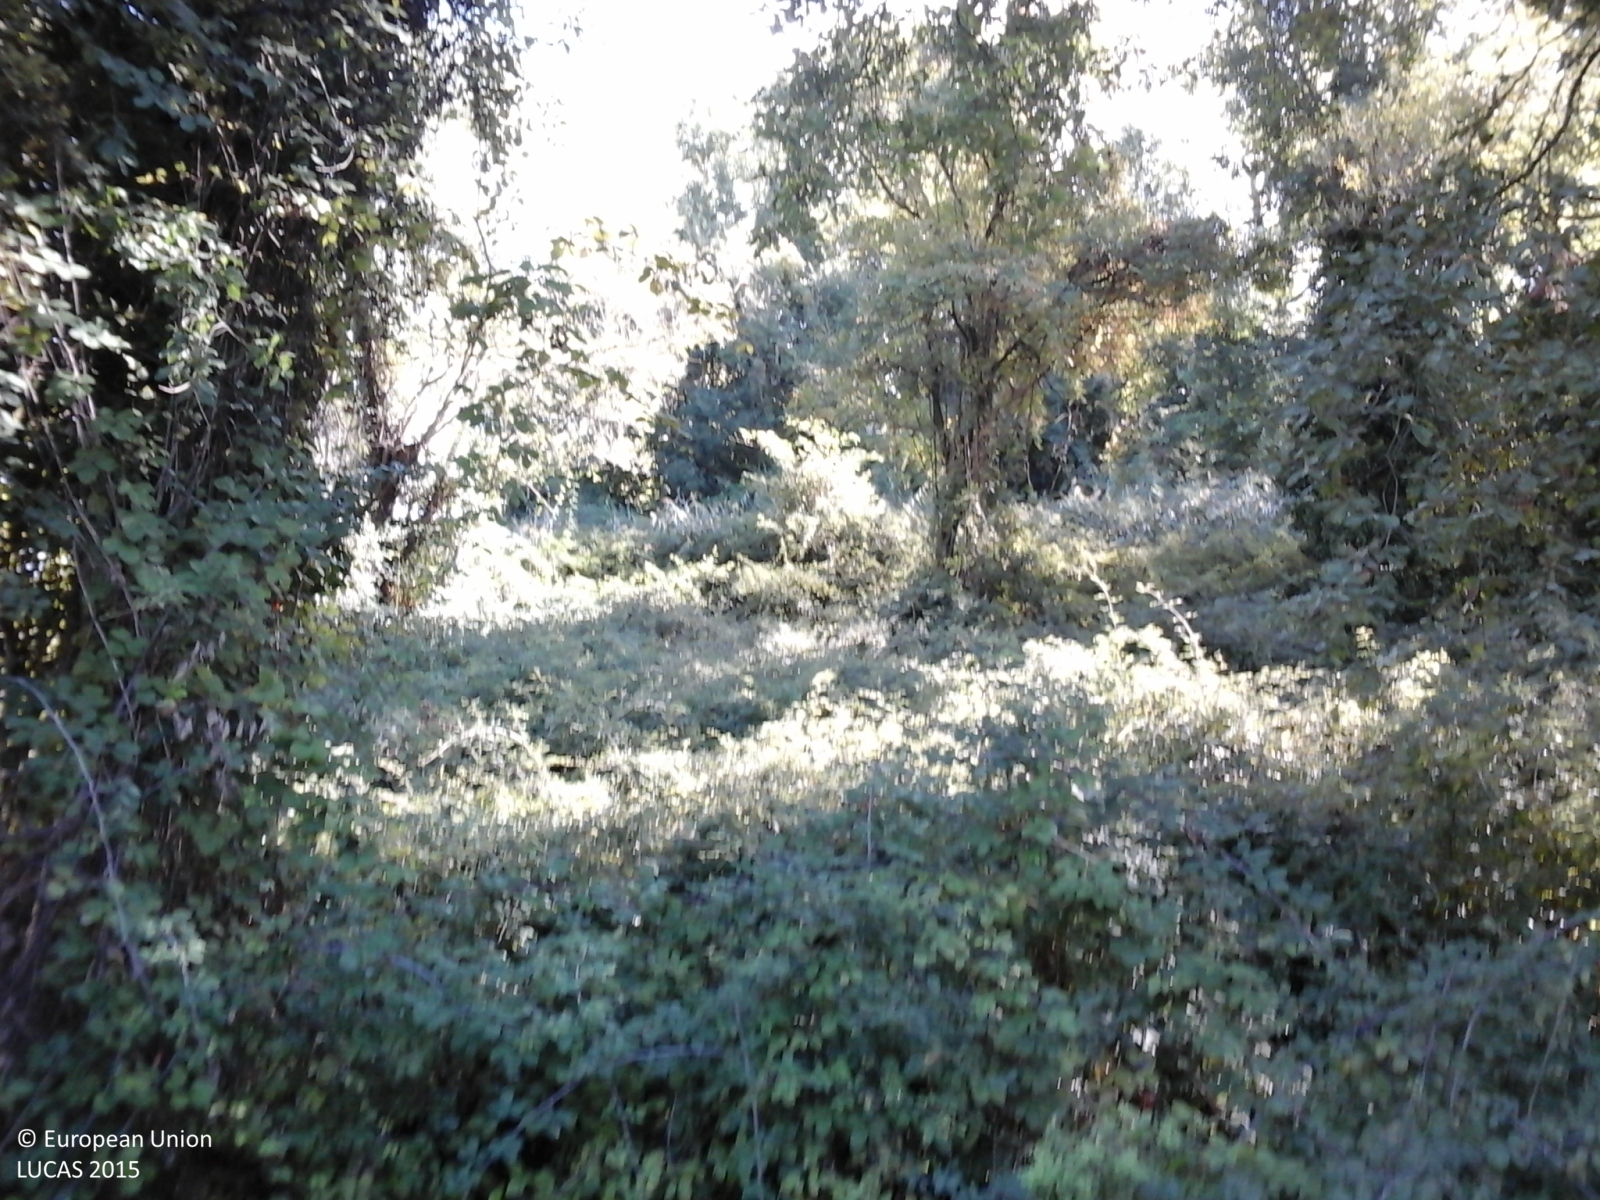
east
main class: Woodland
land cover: Broadleaved woodland
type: thermophilous deciduous forest
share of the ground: > 75 %
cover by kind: broadleaved forest trees 100 %
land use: Forestry
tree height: > 5 m
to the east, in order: Broadleaved woodland; Tracks; Sunflower; Durum wheat
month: October
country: IT
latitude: 43.5727
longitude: 13.3970
